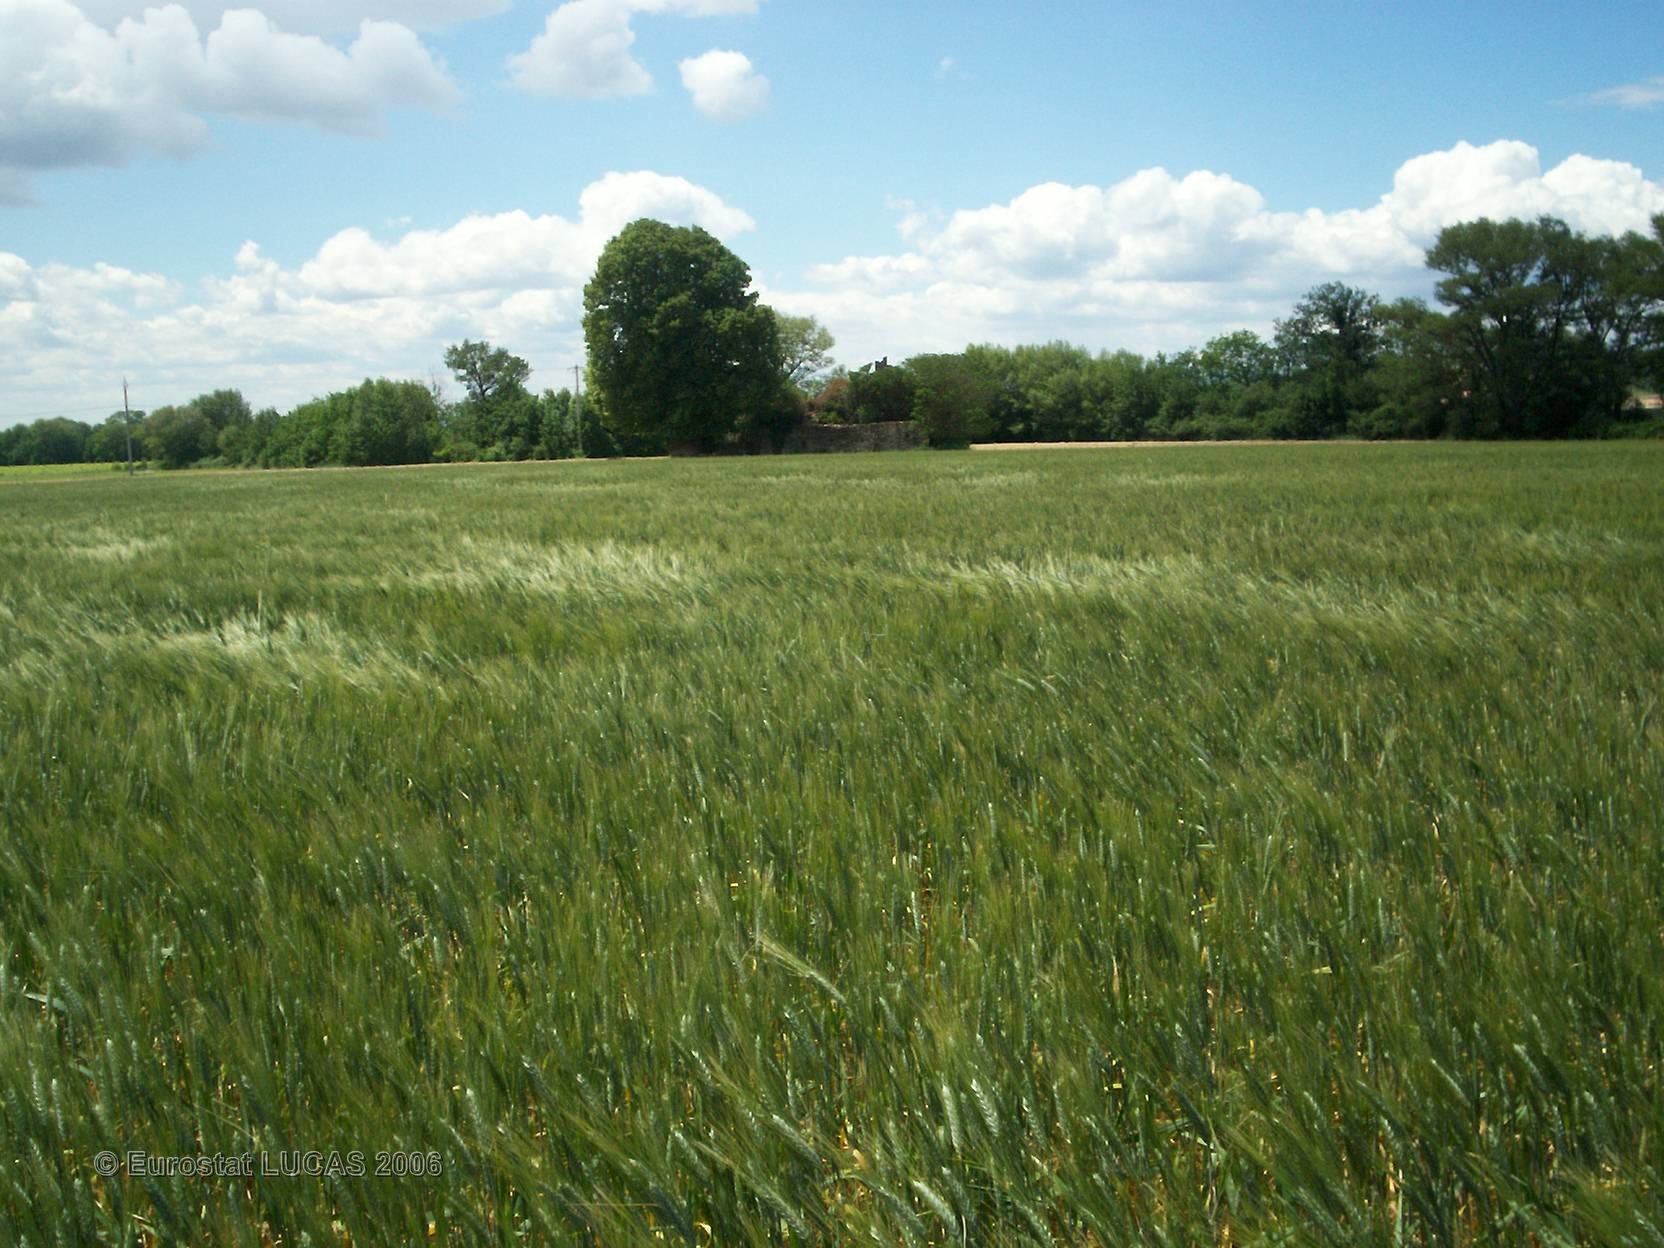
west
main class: Cropland
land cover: Durum wheat
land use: Agriculture (excluding fallow land and kitchen gardens)
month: May
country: FR
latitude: 44.5700
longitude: 4.9322
